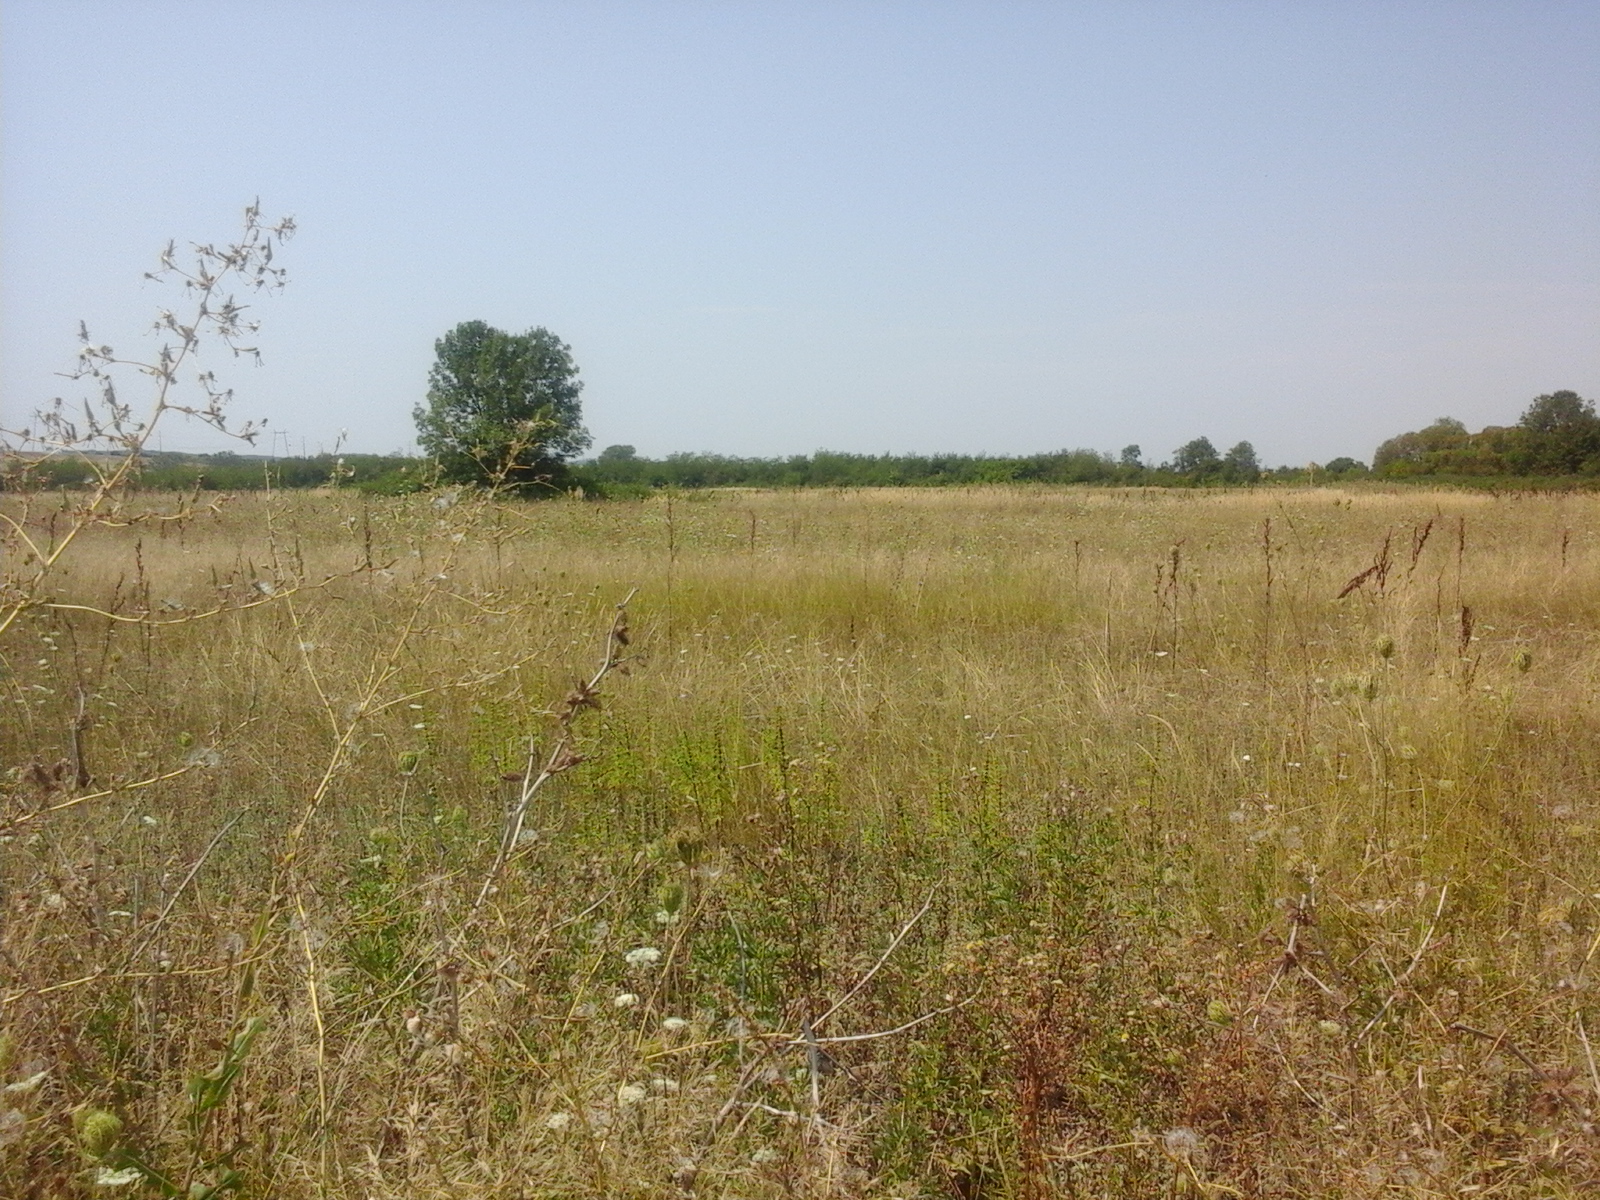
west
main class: Grassland
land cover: Spontaneously vegetated surfaces
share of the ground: > 75 %
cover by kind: herbaceous plants 100 %
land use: Agriculture (excluding fallow land and kitchen gardens)
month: August
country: RO
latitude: 44.5838
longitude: 23.3136
